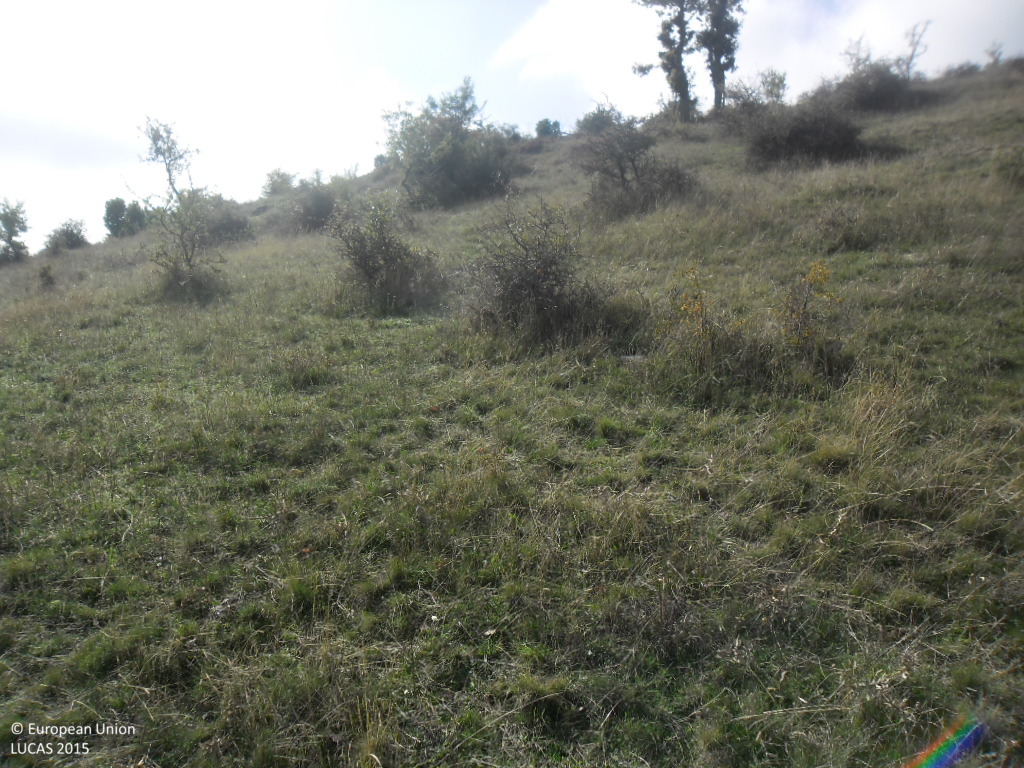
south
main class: Grassland
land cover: Grassland without tree/shrub cover
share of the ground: > 75 %
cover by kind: herbaceous plants 100 %
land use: Agriculture (excluding fallow land and kitchen gardens)
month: October
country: BG
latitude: 41.9323
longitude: 23.0598
